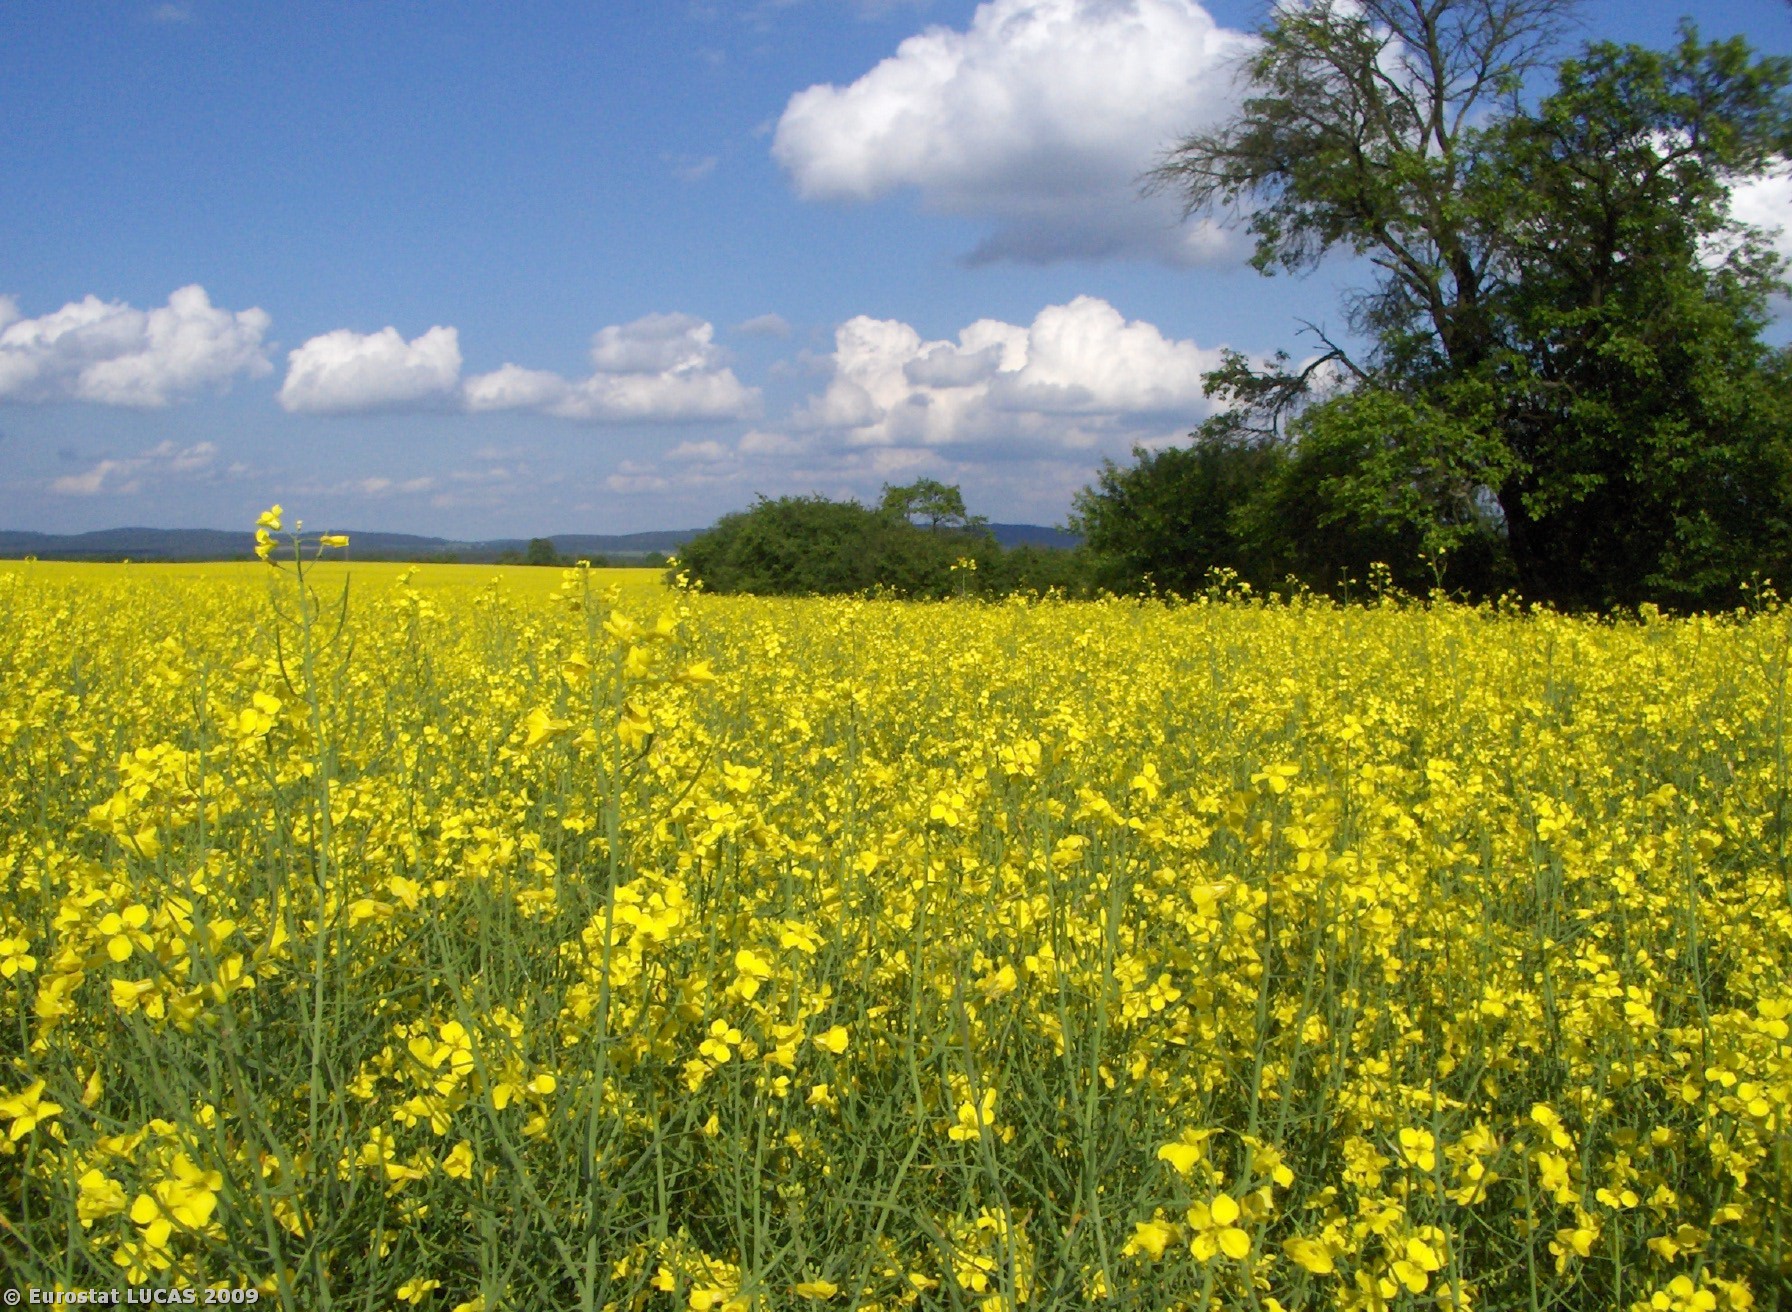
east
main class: Cropland
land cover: Rape and turnip rape
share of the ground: > 75 %
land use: Agriculture (excluding fallow land and kitchen gardens)
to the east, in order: Rape and turnip rape; Broadleaved woodland; Tracks; Ditches and canals; Broadleaved woodland; Grassland without tree/shrub cover
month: May
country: CZ
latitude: 49.3685
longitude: 14.2011
